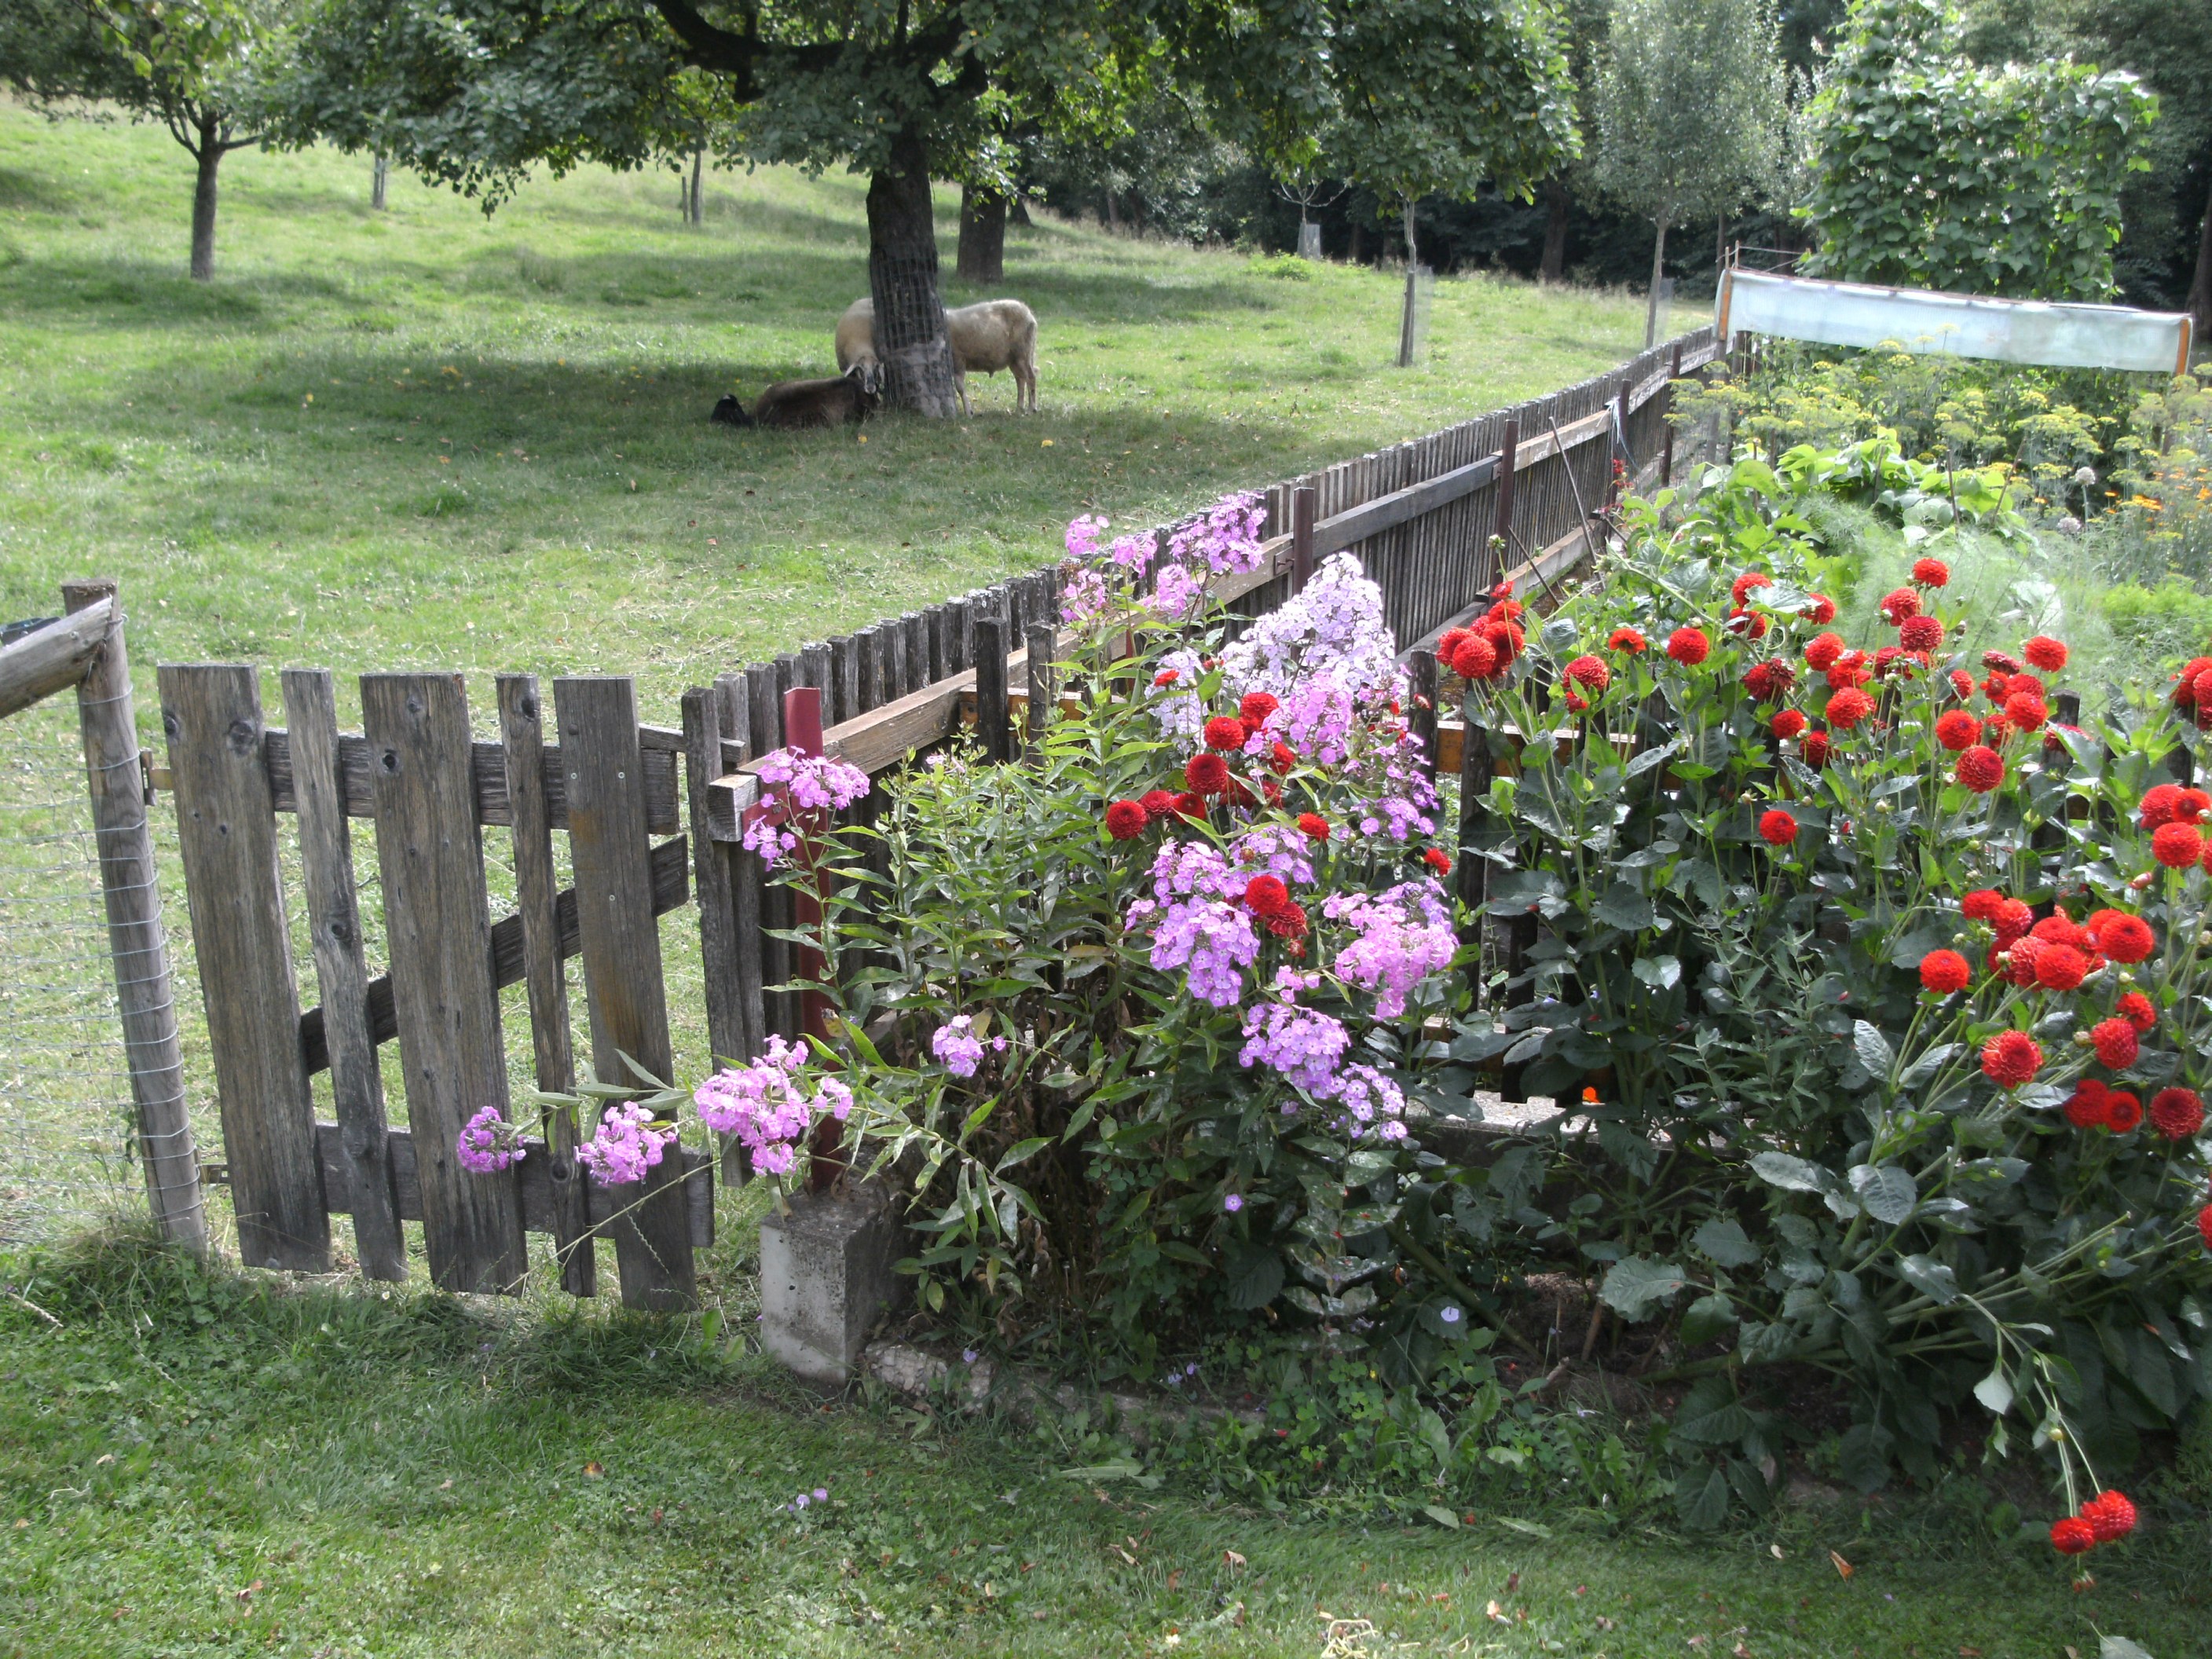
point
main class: Cropland
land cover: Apple fruit
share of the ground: 50 - 75 %
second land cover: Grassland without tree/shrub cover
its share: 25 - 50 %
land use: Agriculture (excluding fallow land and kitchen gardens)
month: July
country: AT
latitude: 46.8395
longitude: 14.7842
